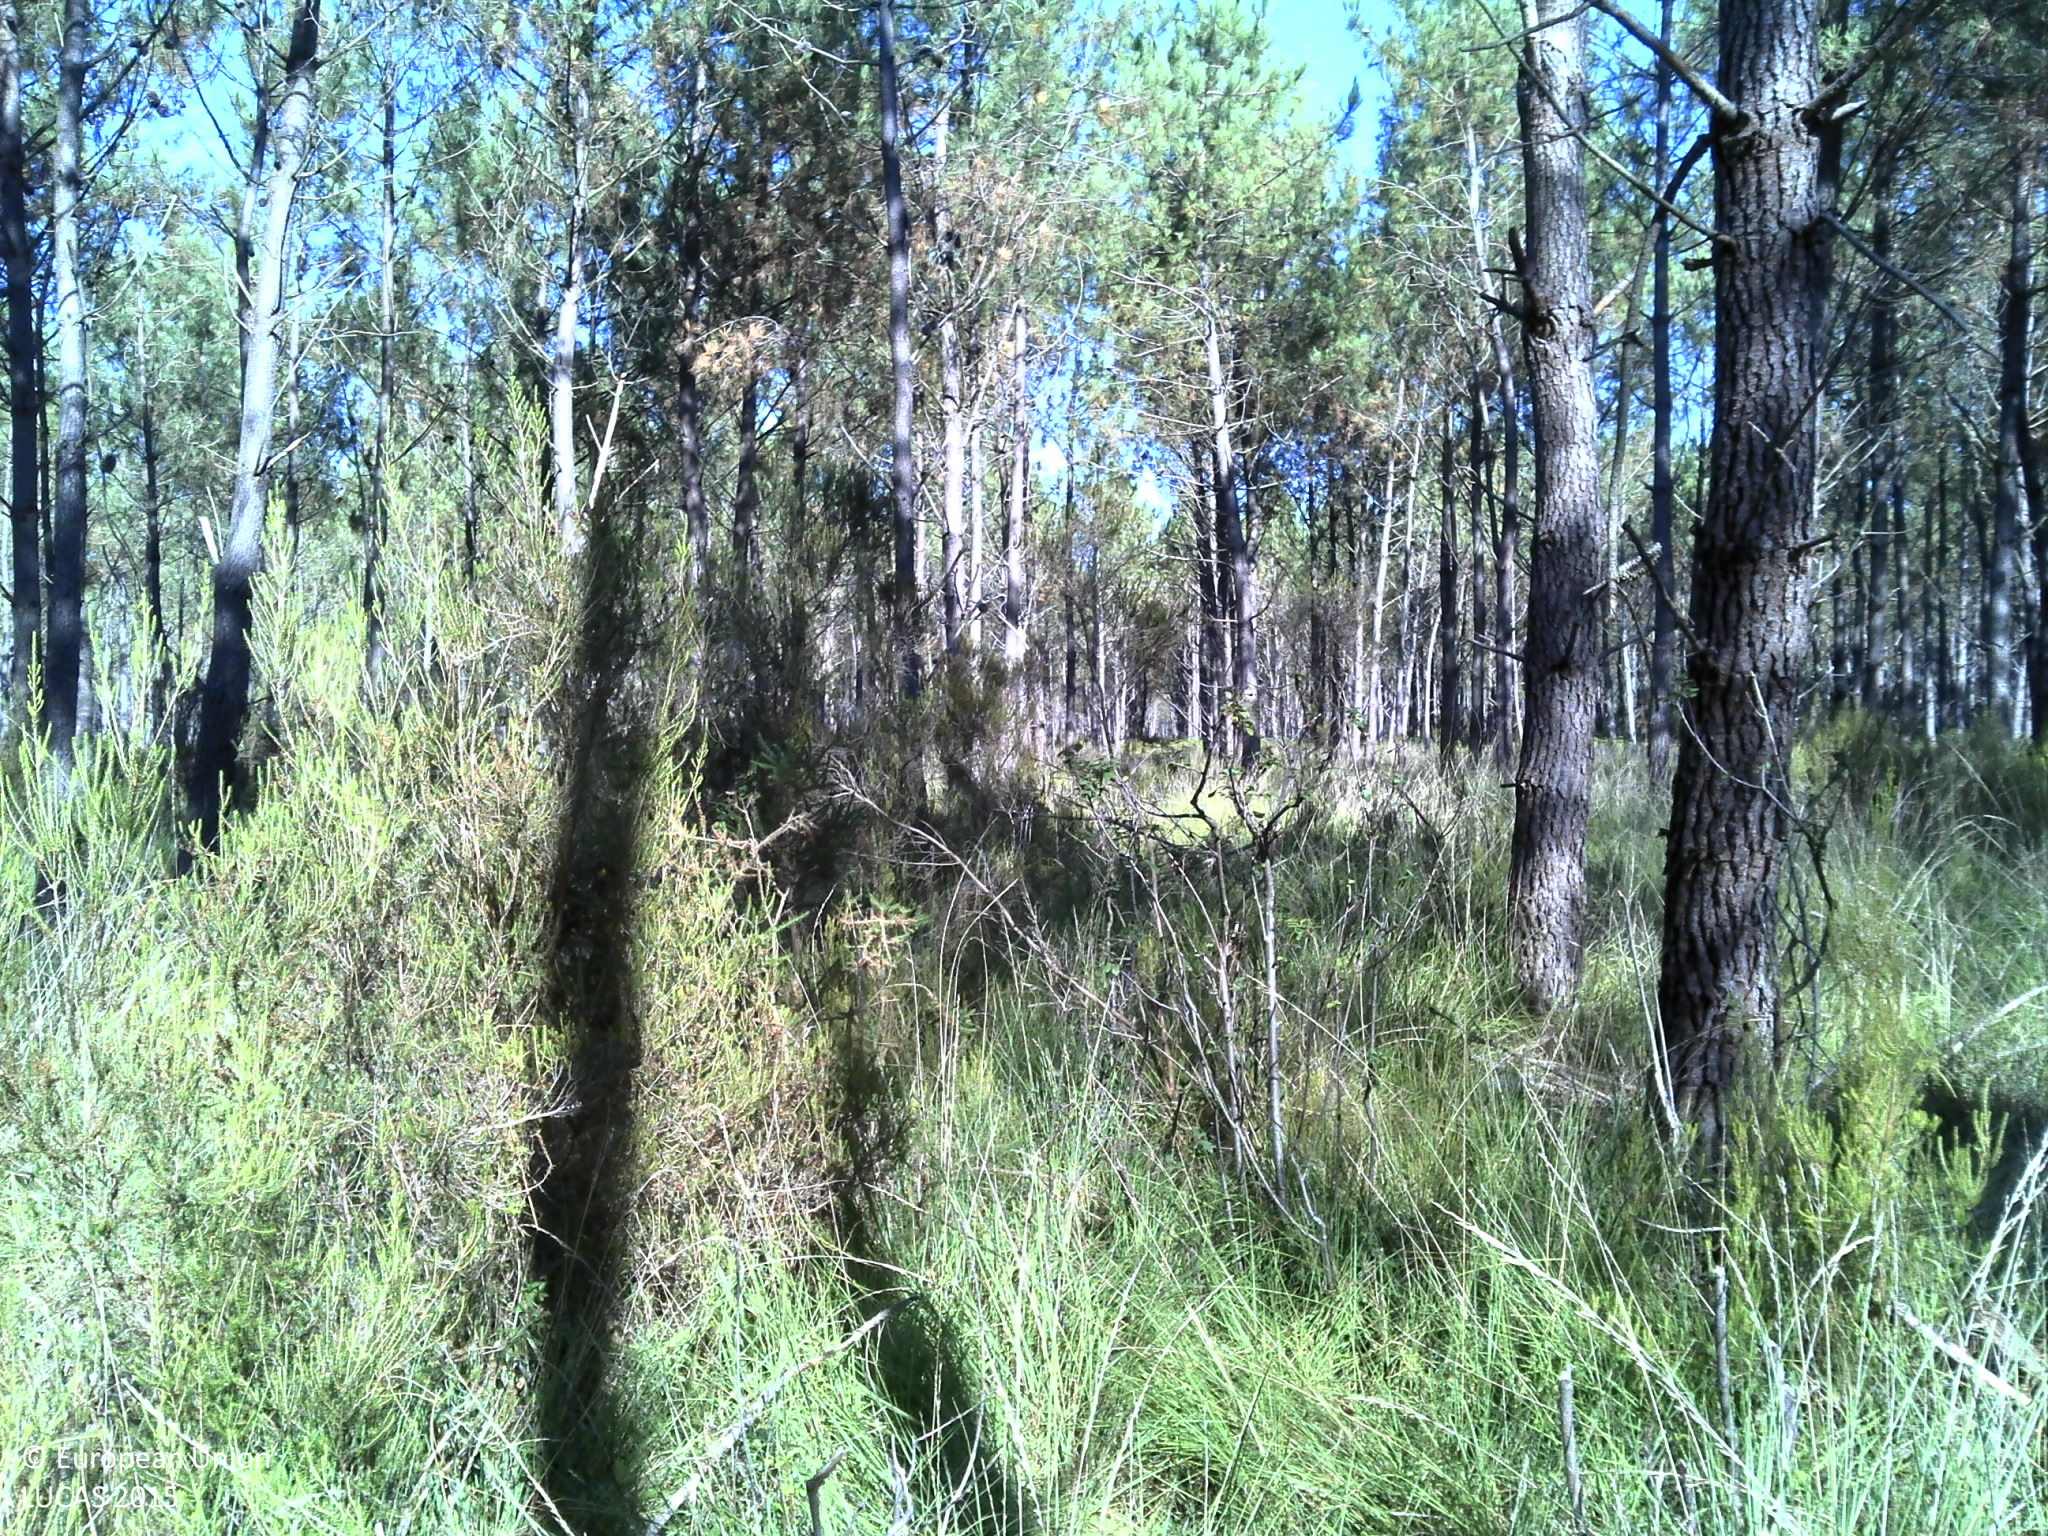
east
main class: Woodland
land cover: Pine dominated coniferous woodland
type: coniferous forest of the mediterranean region
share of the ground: > 75 %
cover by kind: herbaceous plants 50 %, coniferous forest trees 30 %, shrubs 20 %
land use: Forestry
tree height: > 5 m
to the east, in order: Pine dominated coniferous woodland
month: August
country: FR
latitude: 45.2269
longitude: -1.0938
